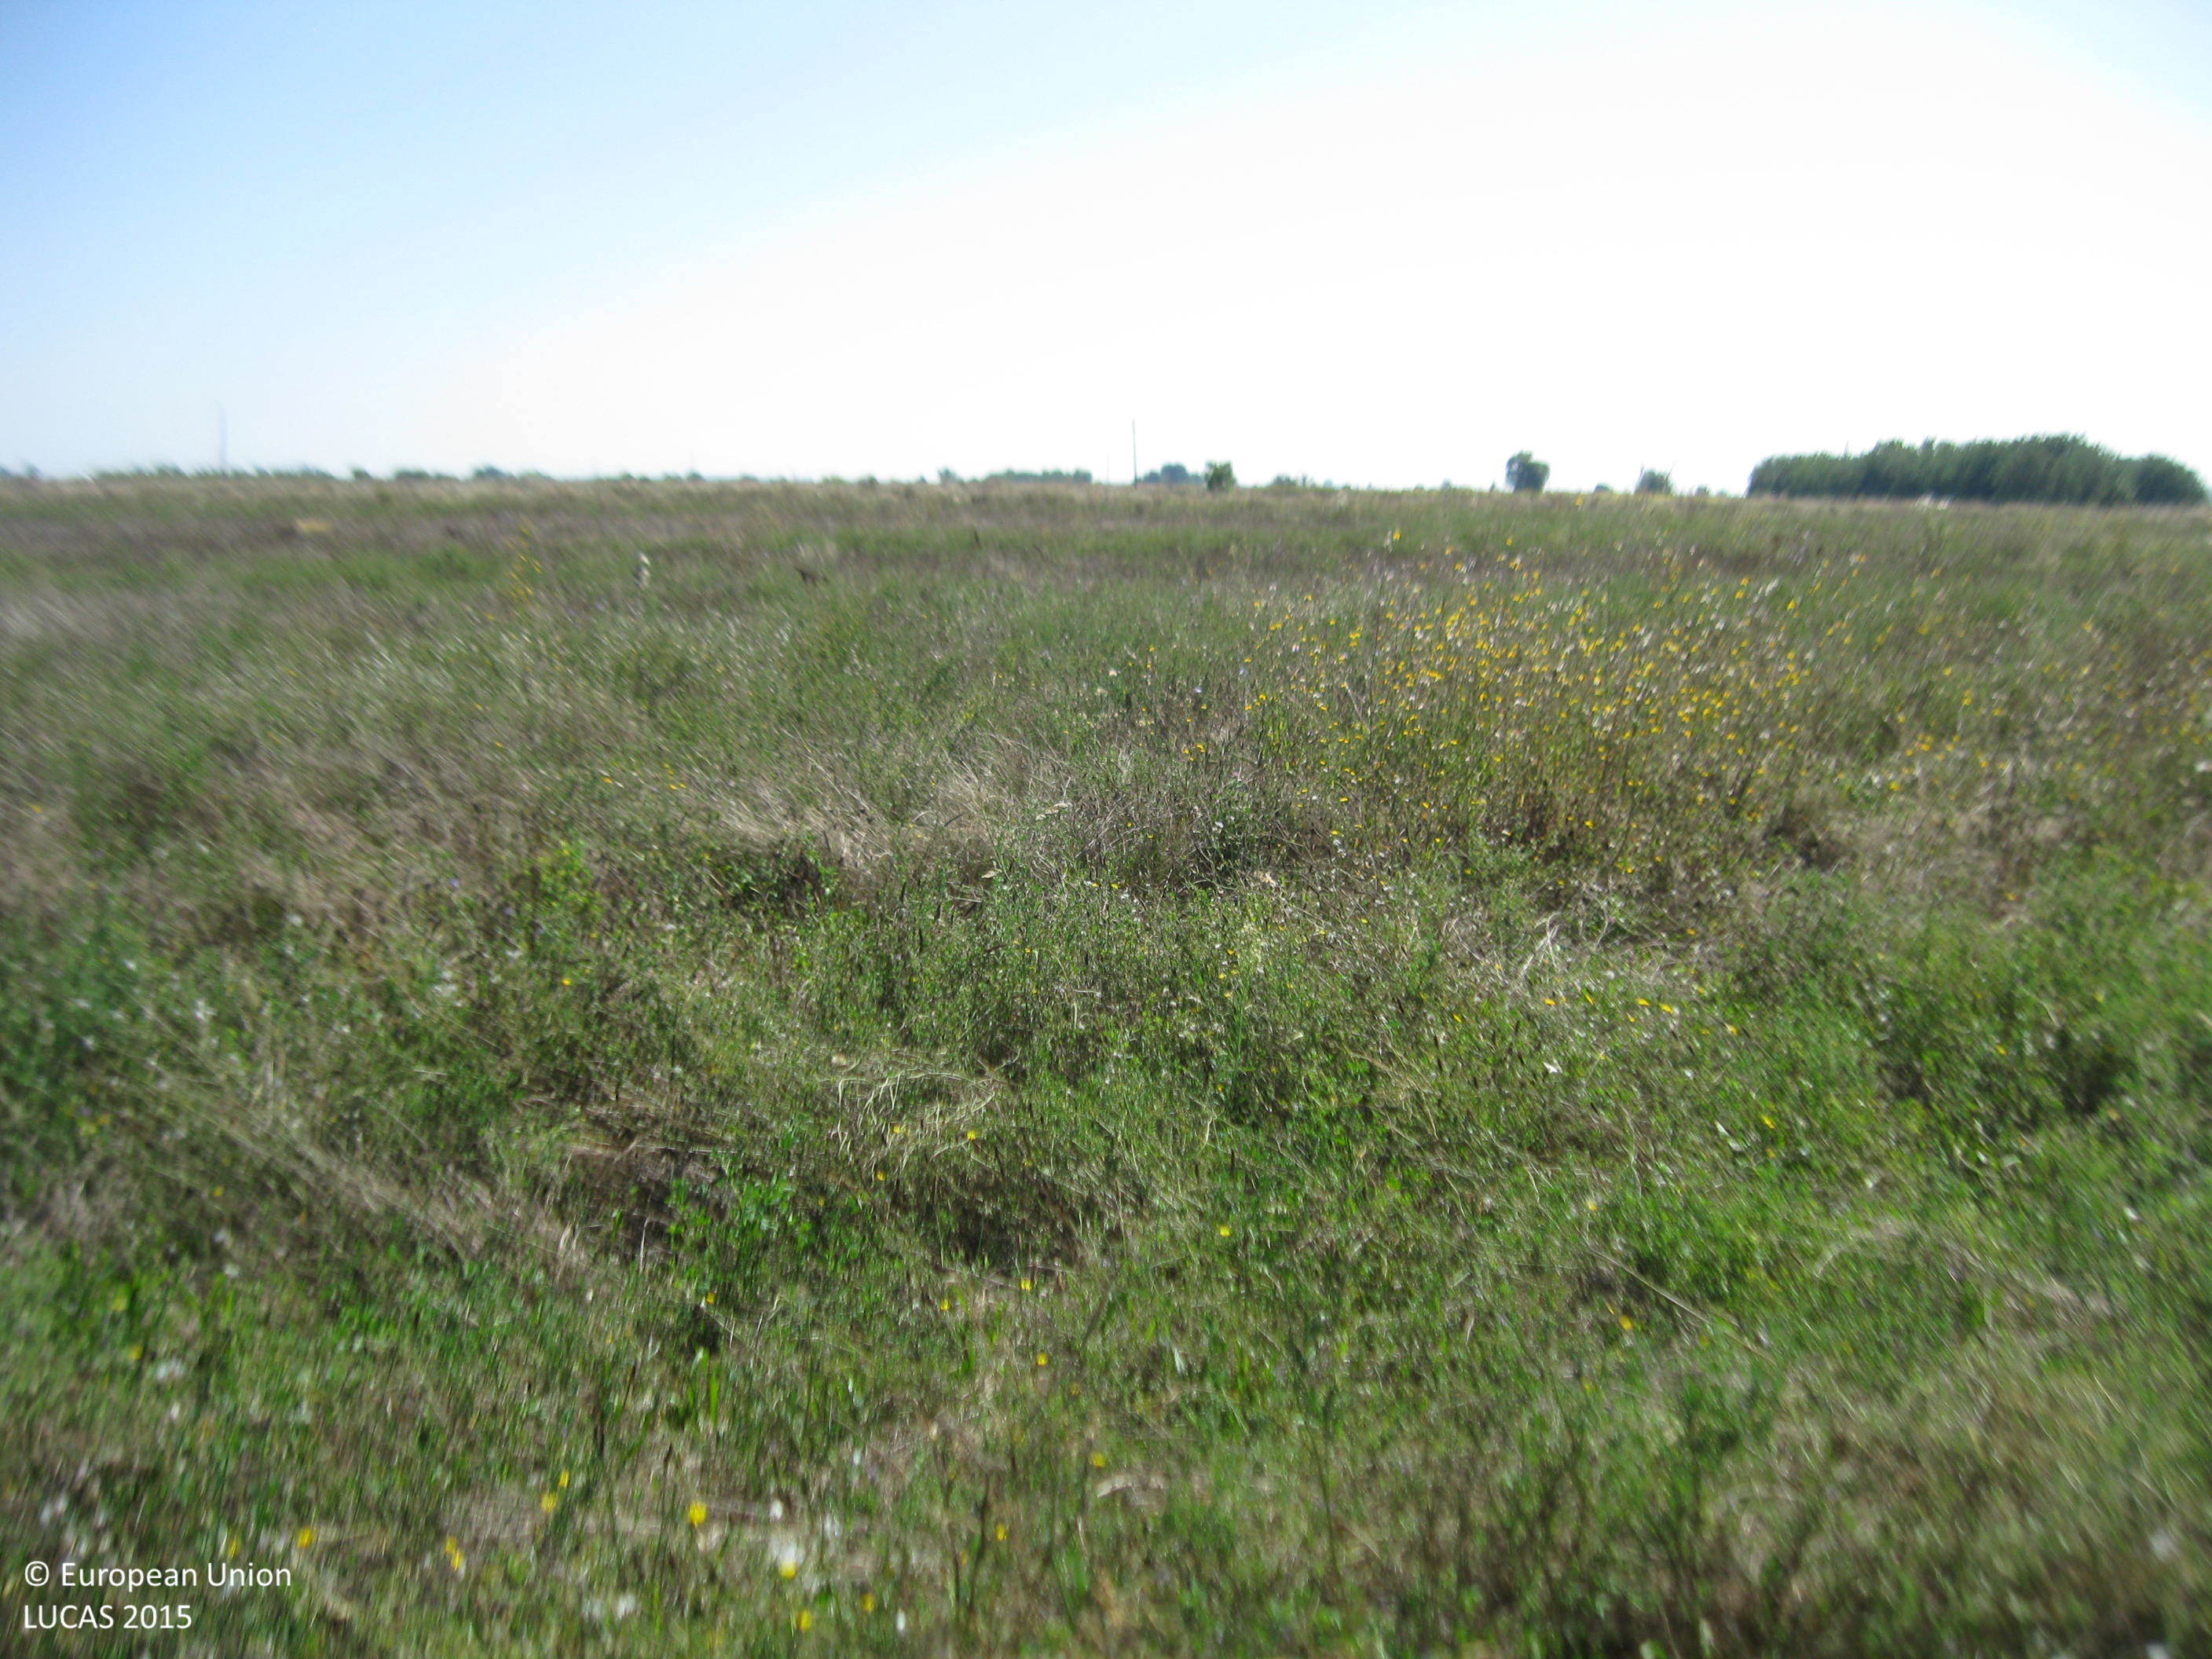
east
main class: Cropland
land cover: Lucerne
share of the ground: 50 - 75 %
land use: Agriculture (excluding fallow land and kitchen gardens)
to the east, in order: Lucerne; Grass margins; Common wheat; Grass margins; Common wheat
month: September
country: BG
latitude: 42.2661
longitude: 24.7341
